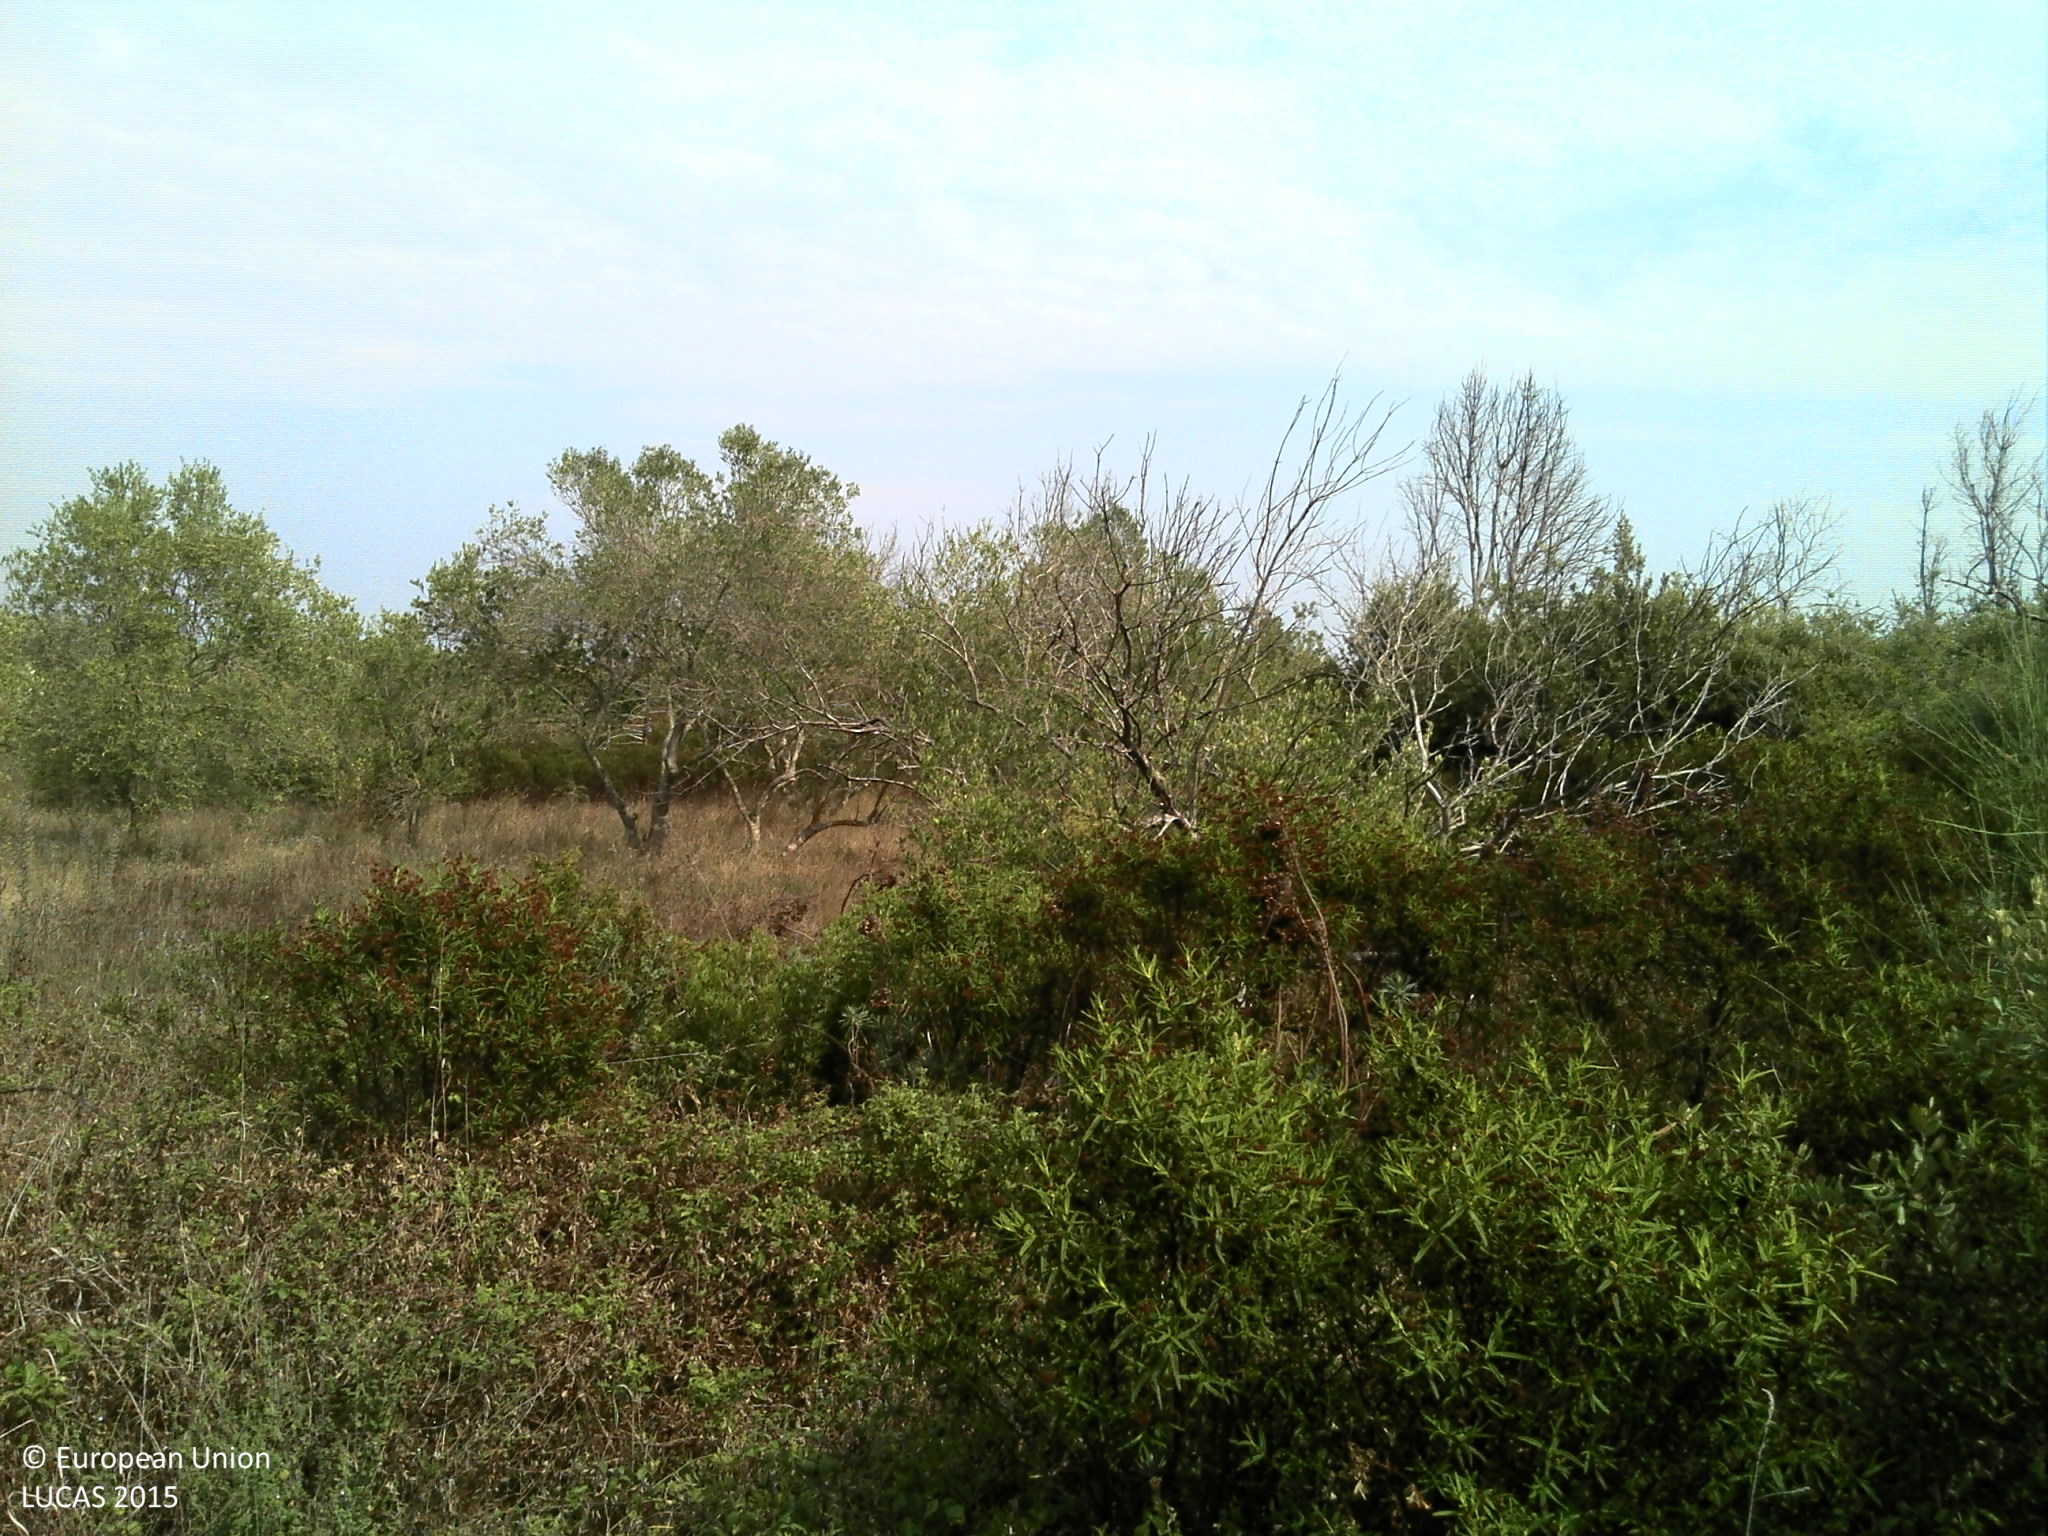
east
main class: Shrubland
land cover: Shrubland with sparse tree cover
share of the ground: 50 - 75 %
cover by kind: shrubs 65 %, herbaceous plants 30 %, coniferous forest trees 5 %
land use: Abandoned areas
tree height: > 5 m
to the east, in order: Shrubland with sparse tree cover; Dry stone walls; Olive groves; Shrubland with sparse tree cover; Dry stone walls; Grassland with sparse tree/shrub cover; Dry stone walls; Olive groves; Grassland with sparse tree/shrub cover; Electric lines; Dry stone walls; Olive groves; Grassland without tree/shrub cover
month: September
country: HR
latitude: 44.1358
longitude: 15.0793
